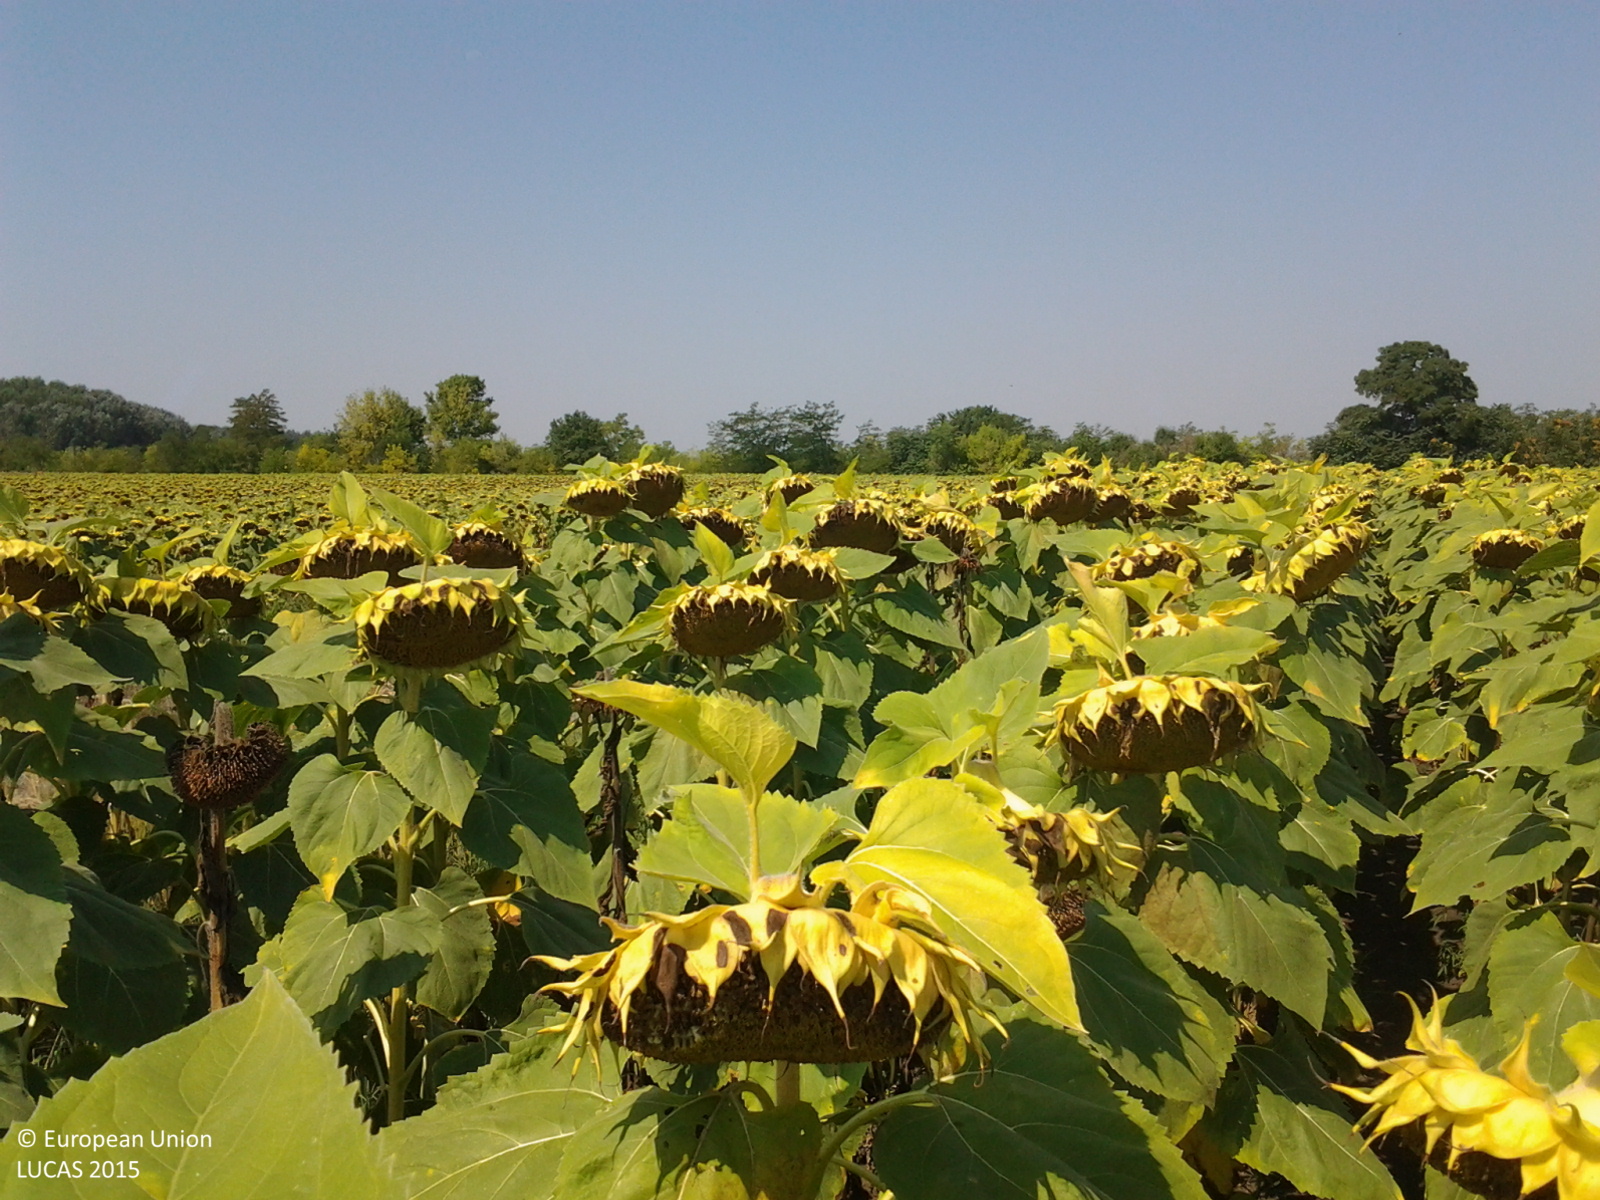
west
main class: Cropland
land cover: Sunflower
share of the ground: > 75 %
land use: Agriculture (excluding fallow land and kitchen gardens)
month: August
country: HU
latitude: 47.3051
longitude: 19.9045
